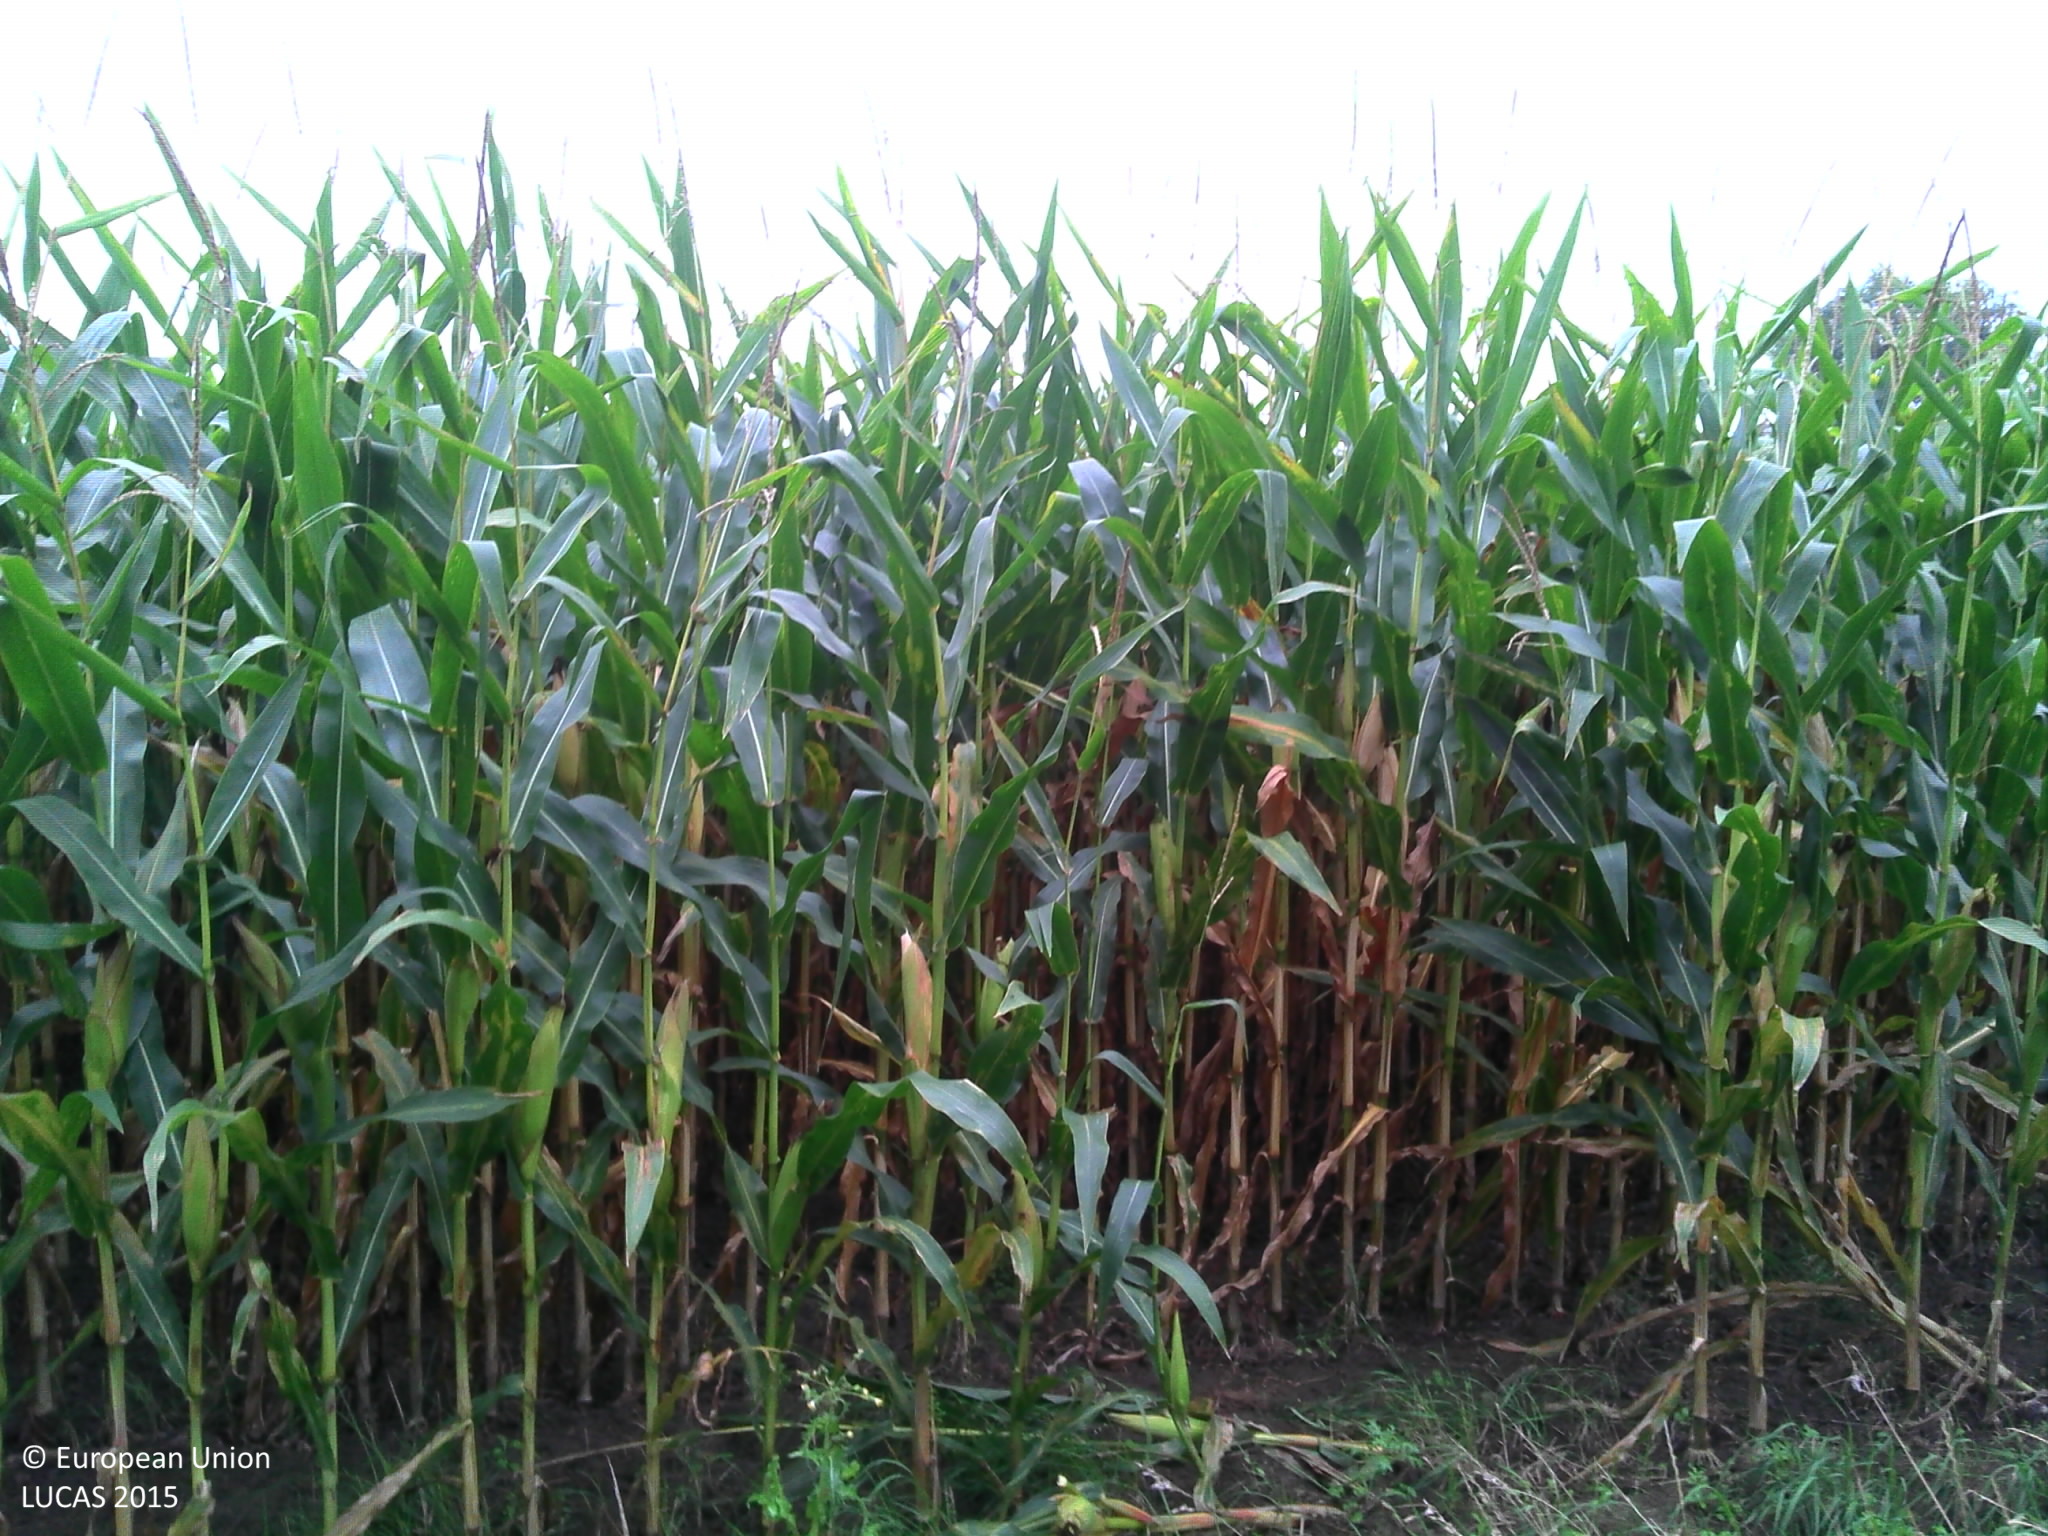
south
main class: Grassland
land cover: Grassland without tree/shrub cover
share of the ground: > 75 %
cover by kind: herbaceous plants 100 %
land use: Agriculture (excluding fallow land and kitchen gardens)
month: September
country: BE
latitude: 50.9866
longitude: 3.4246
